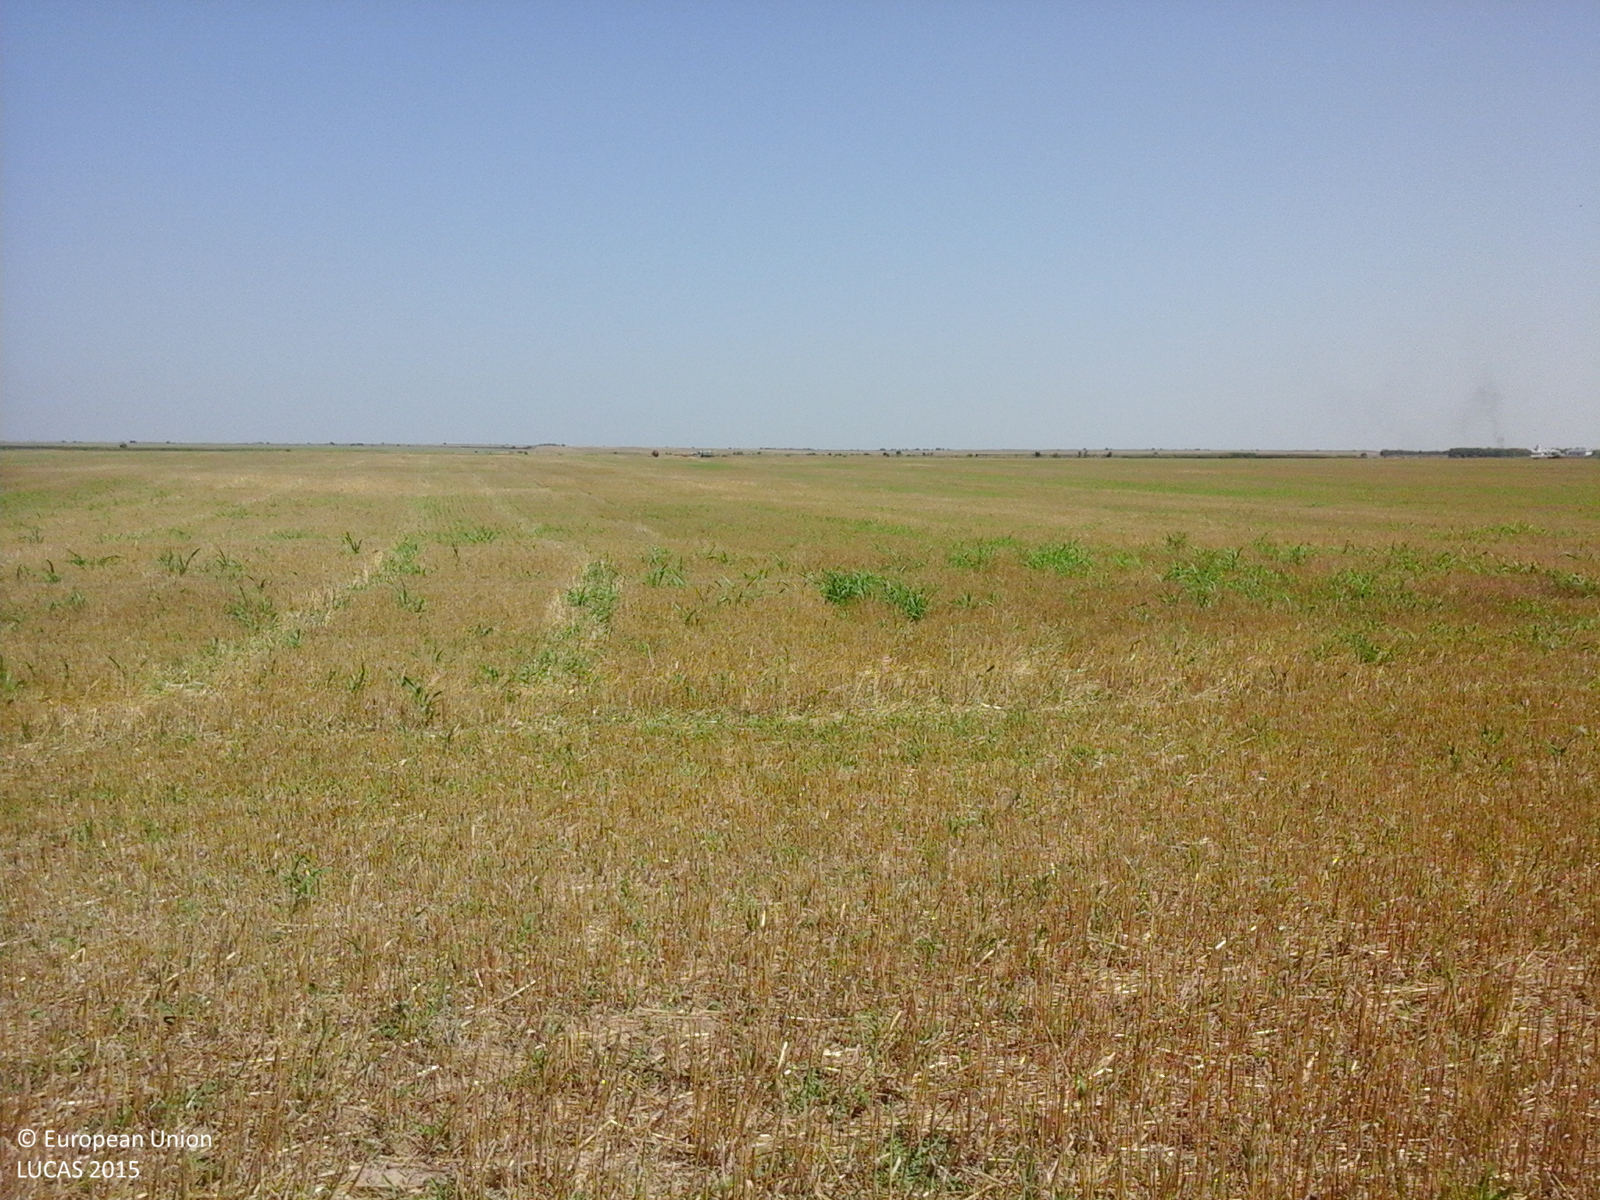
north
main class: Cropland
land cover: Maize
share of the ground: > 75 %
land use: Agriculture (excluding fallow land and kitchen gardens)
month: July
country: RO
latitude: 44.2518
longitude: 27.4854
